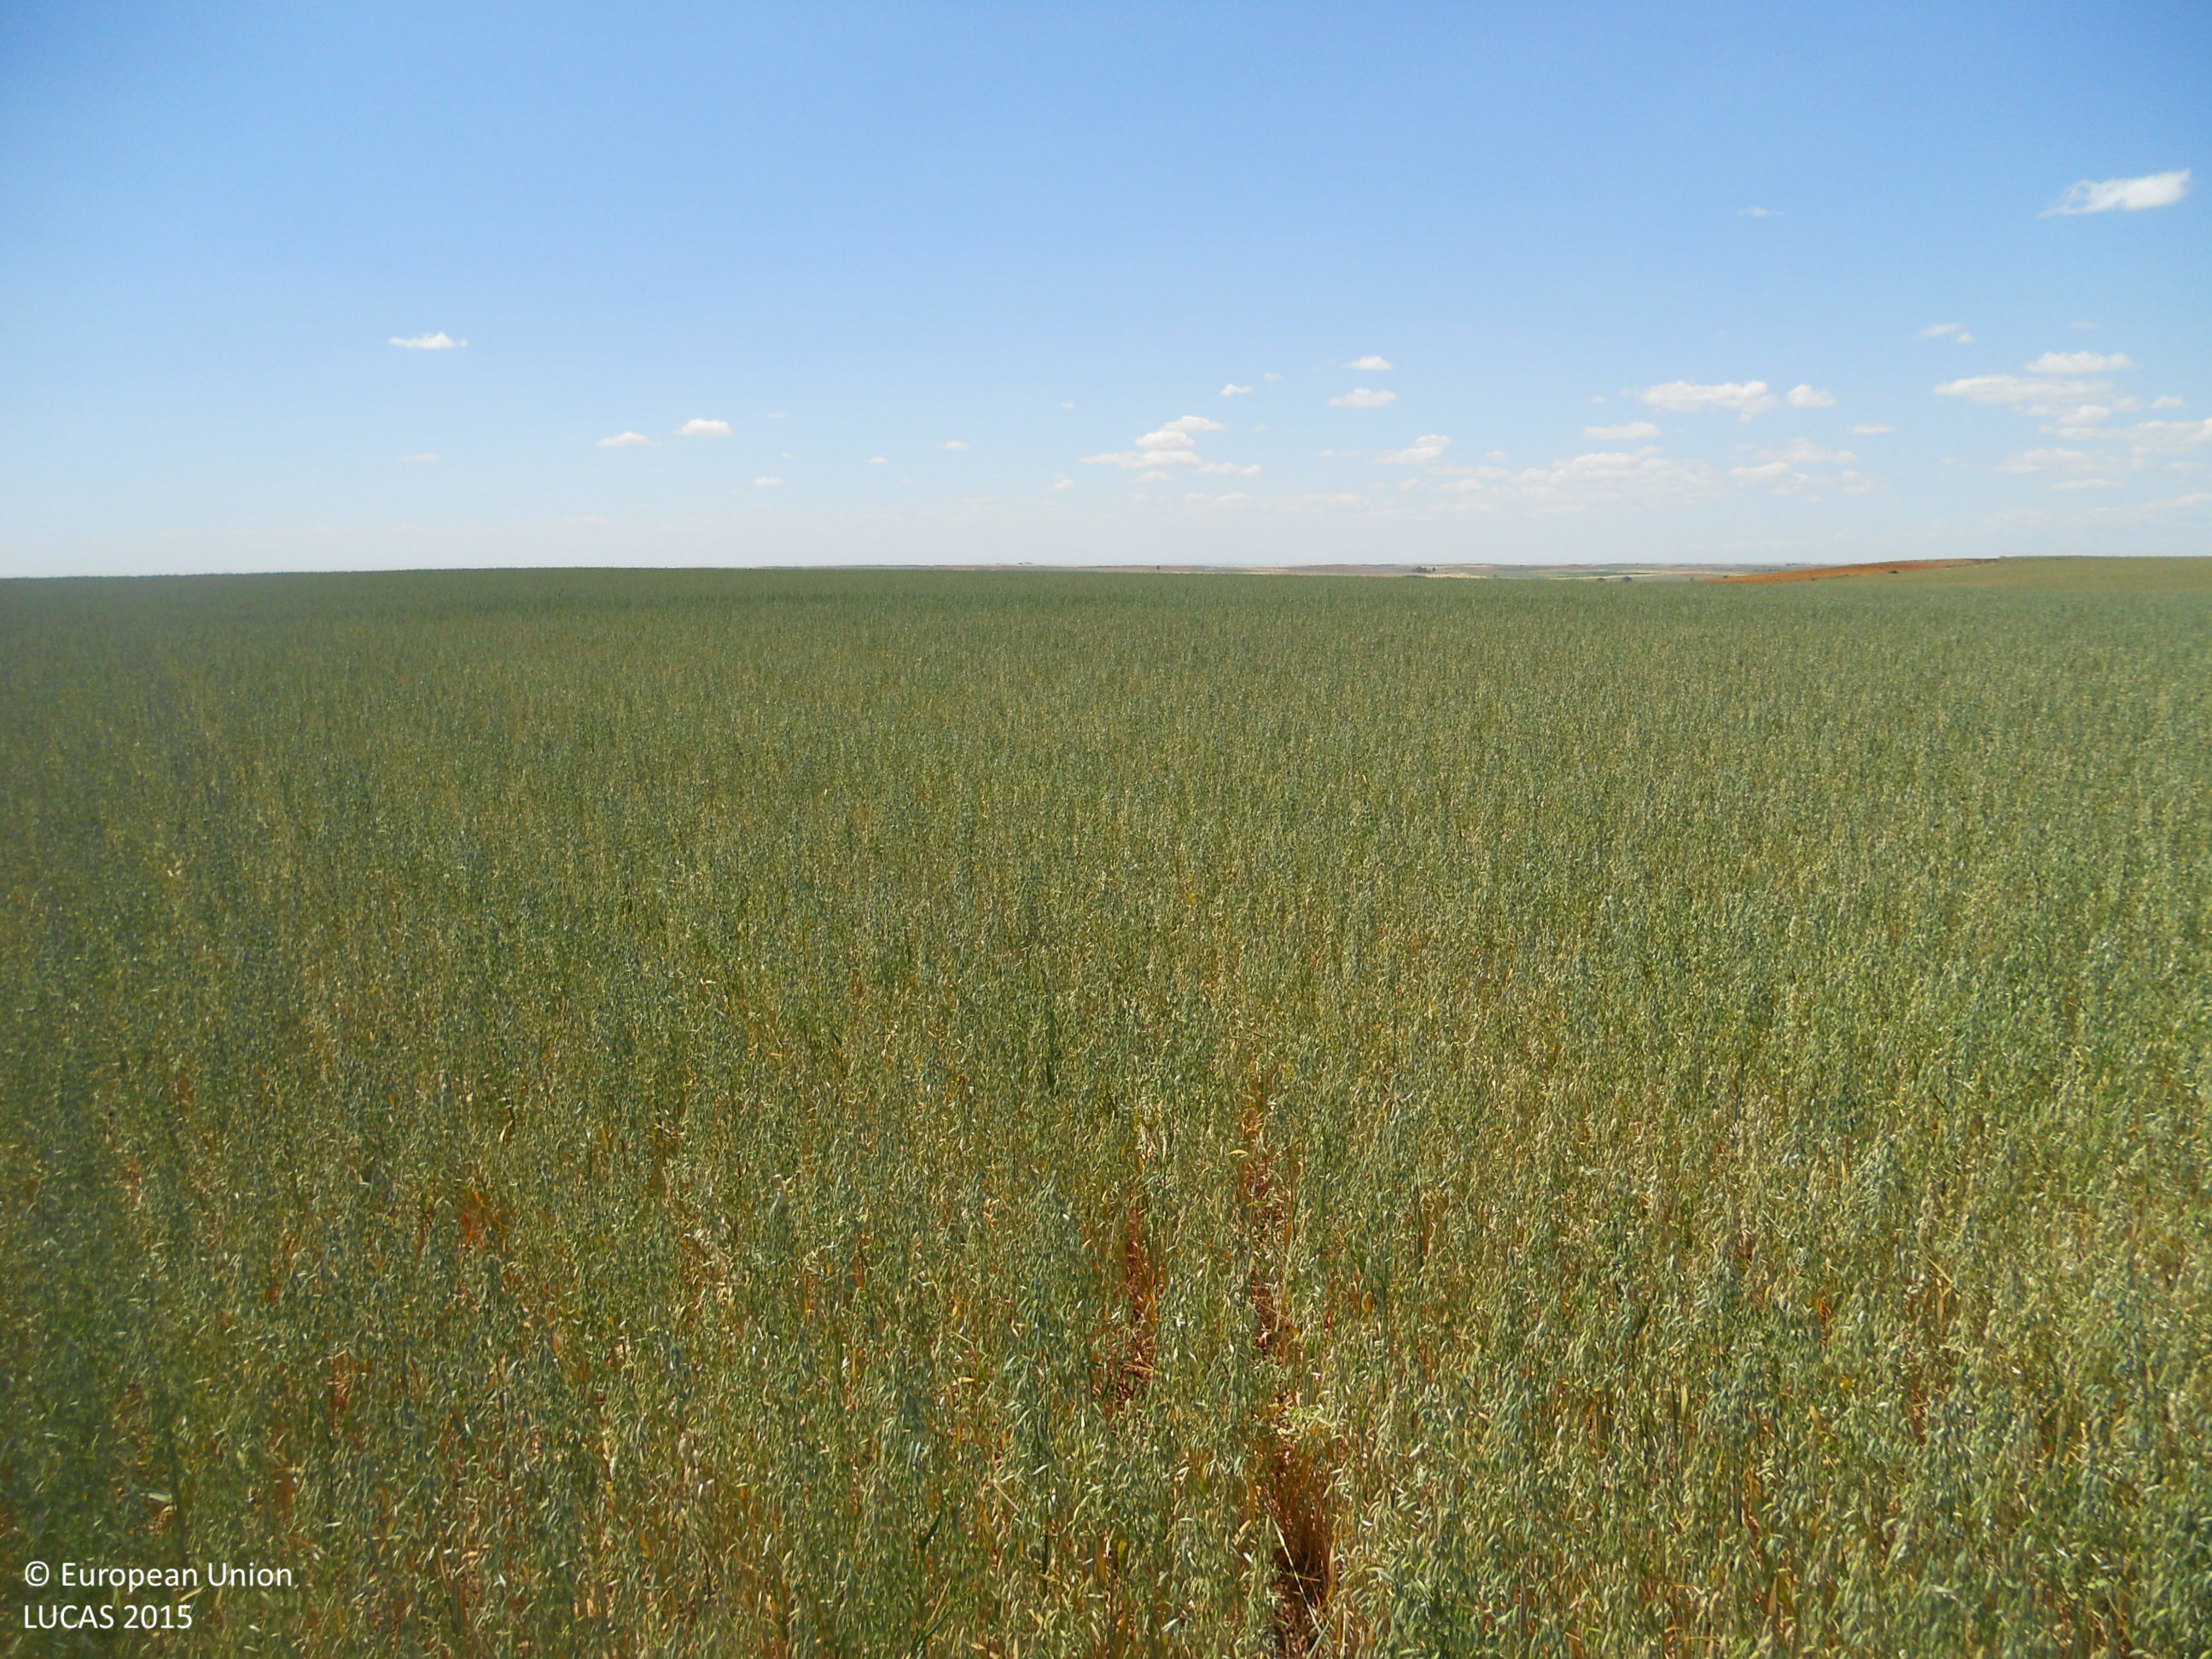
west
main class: Cropland
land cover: Oats
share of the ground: > 75 %
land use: Agriculture (excluding fallow land and kitchen gardens)
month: May
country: ES
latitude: 42.3086
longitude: -4.8187
